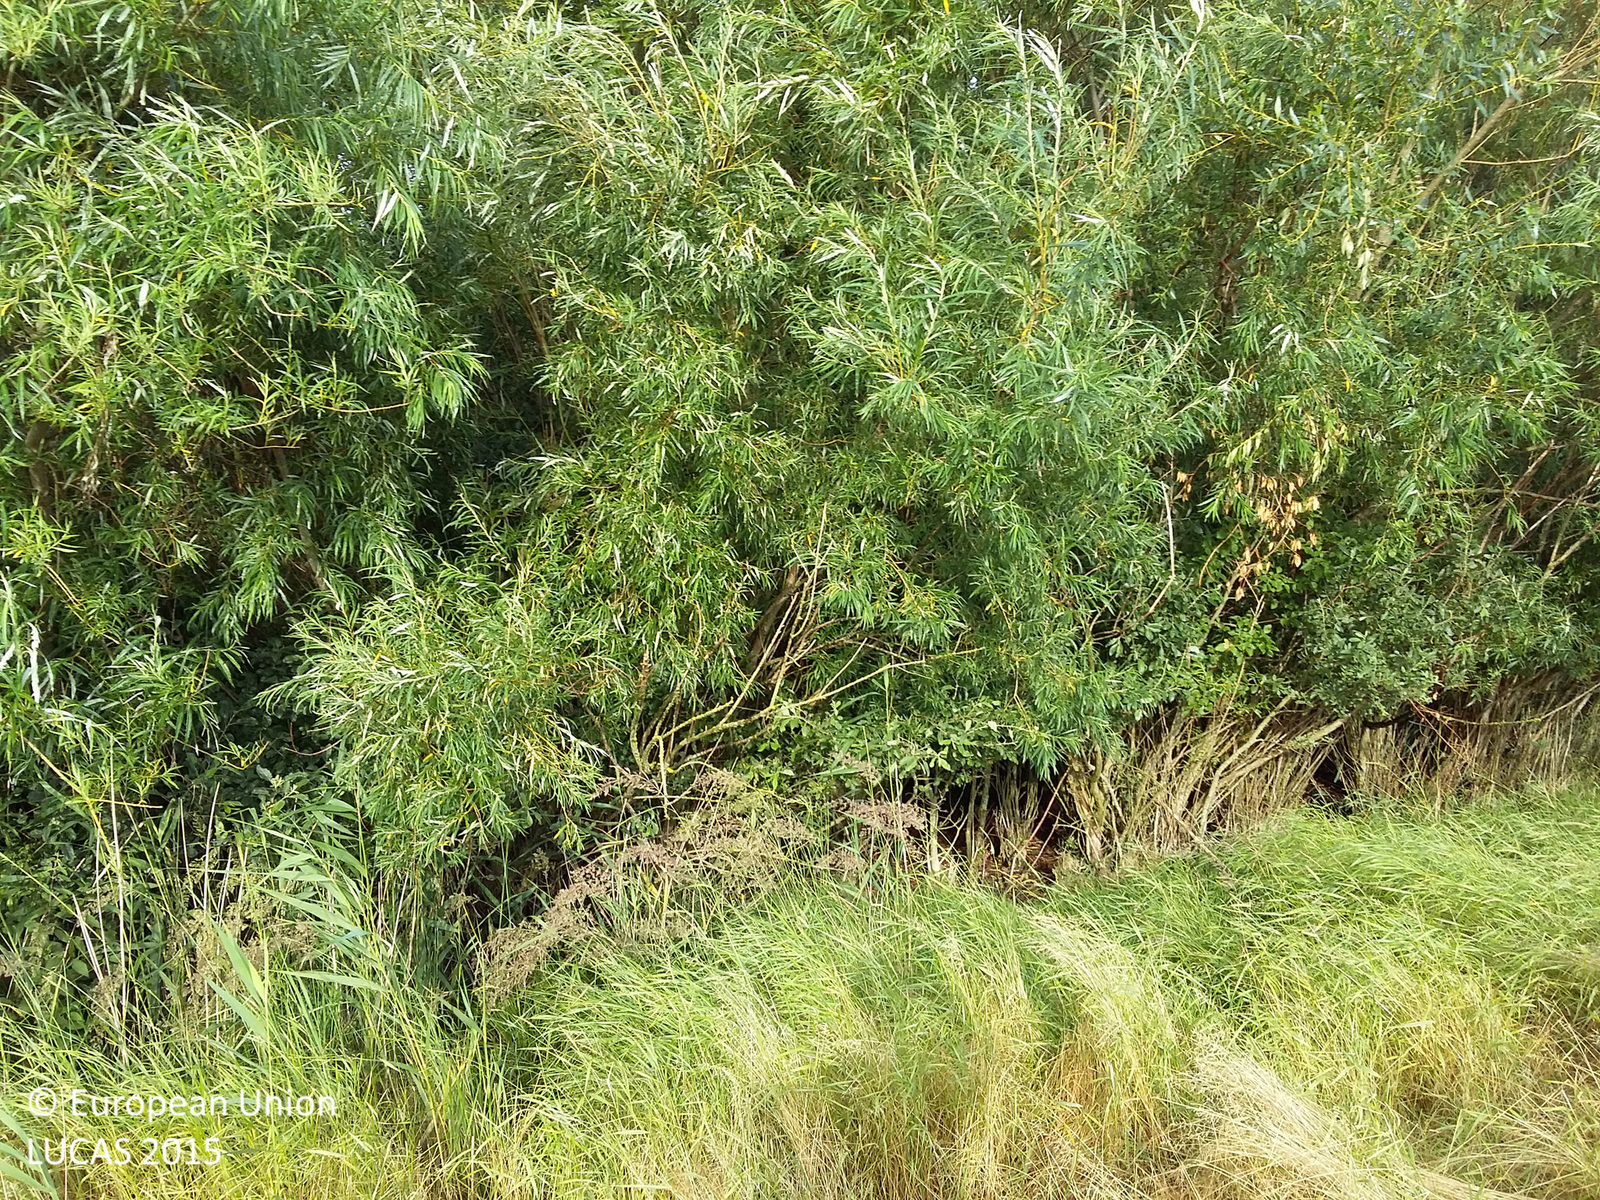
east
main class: Cropland
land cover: Rape and turnip rape
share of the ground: > 75 %
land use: Agriculture (excluding fallow land and kitchen gardens)
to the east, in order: Rape and turnip rape; Broadleaved woodland; Grassland without tree/shrub cover; Rape and turnip rape; Grass margins; Tracks; Grassland without tree/shrub cover
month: July
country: DK
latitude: 55.8640
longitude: 12.1551
